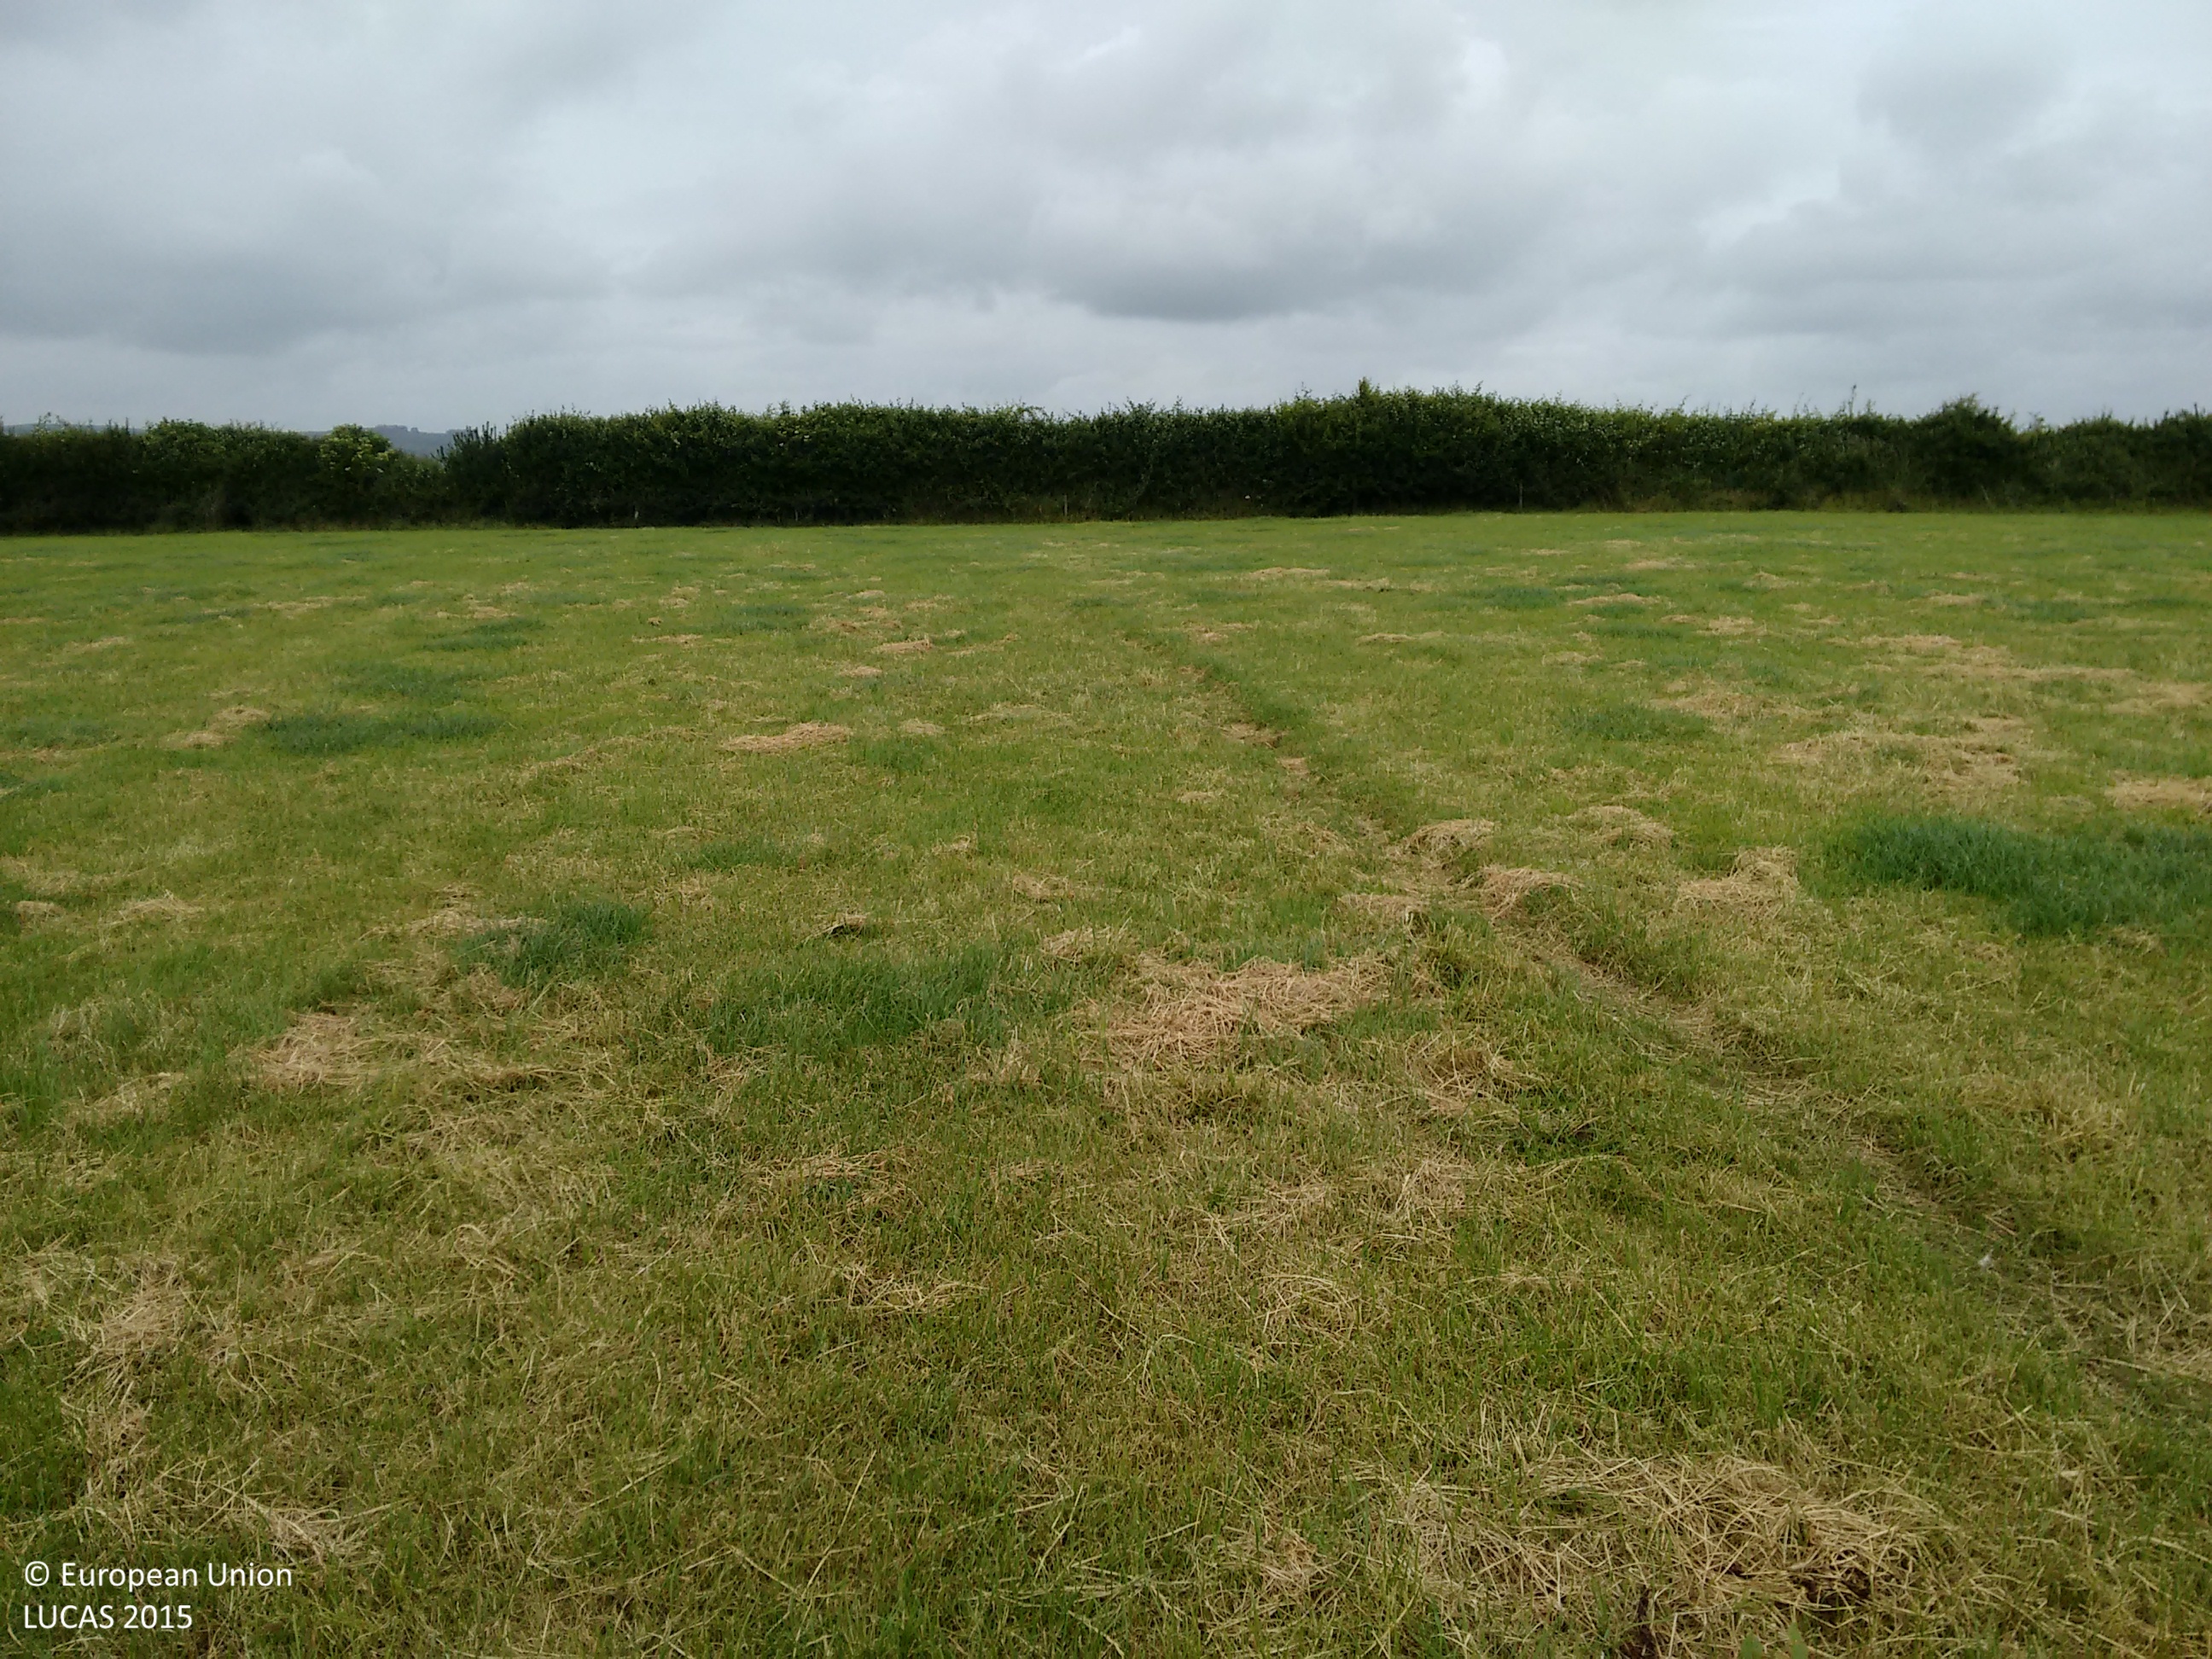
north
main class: Grassland
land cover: Grassland without tree/shrub cover
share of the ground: > 75 %
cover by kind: herbaceous plants 100 %
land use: Agriculture (excluding fallow land and kitchen gardens)
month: June
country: IE
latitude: 52.3653
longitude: -7.4120
